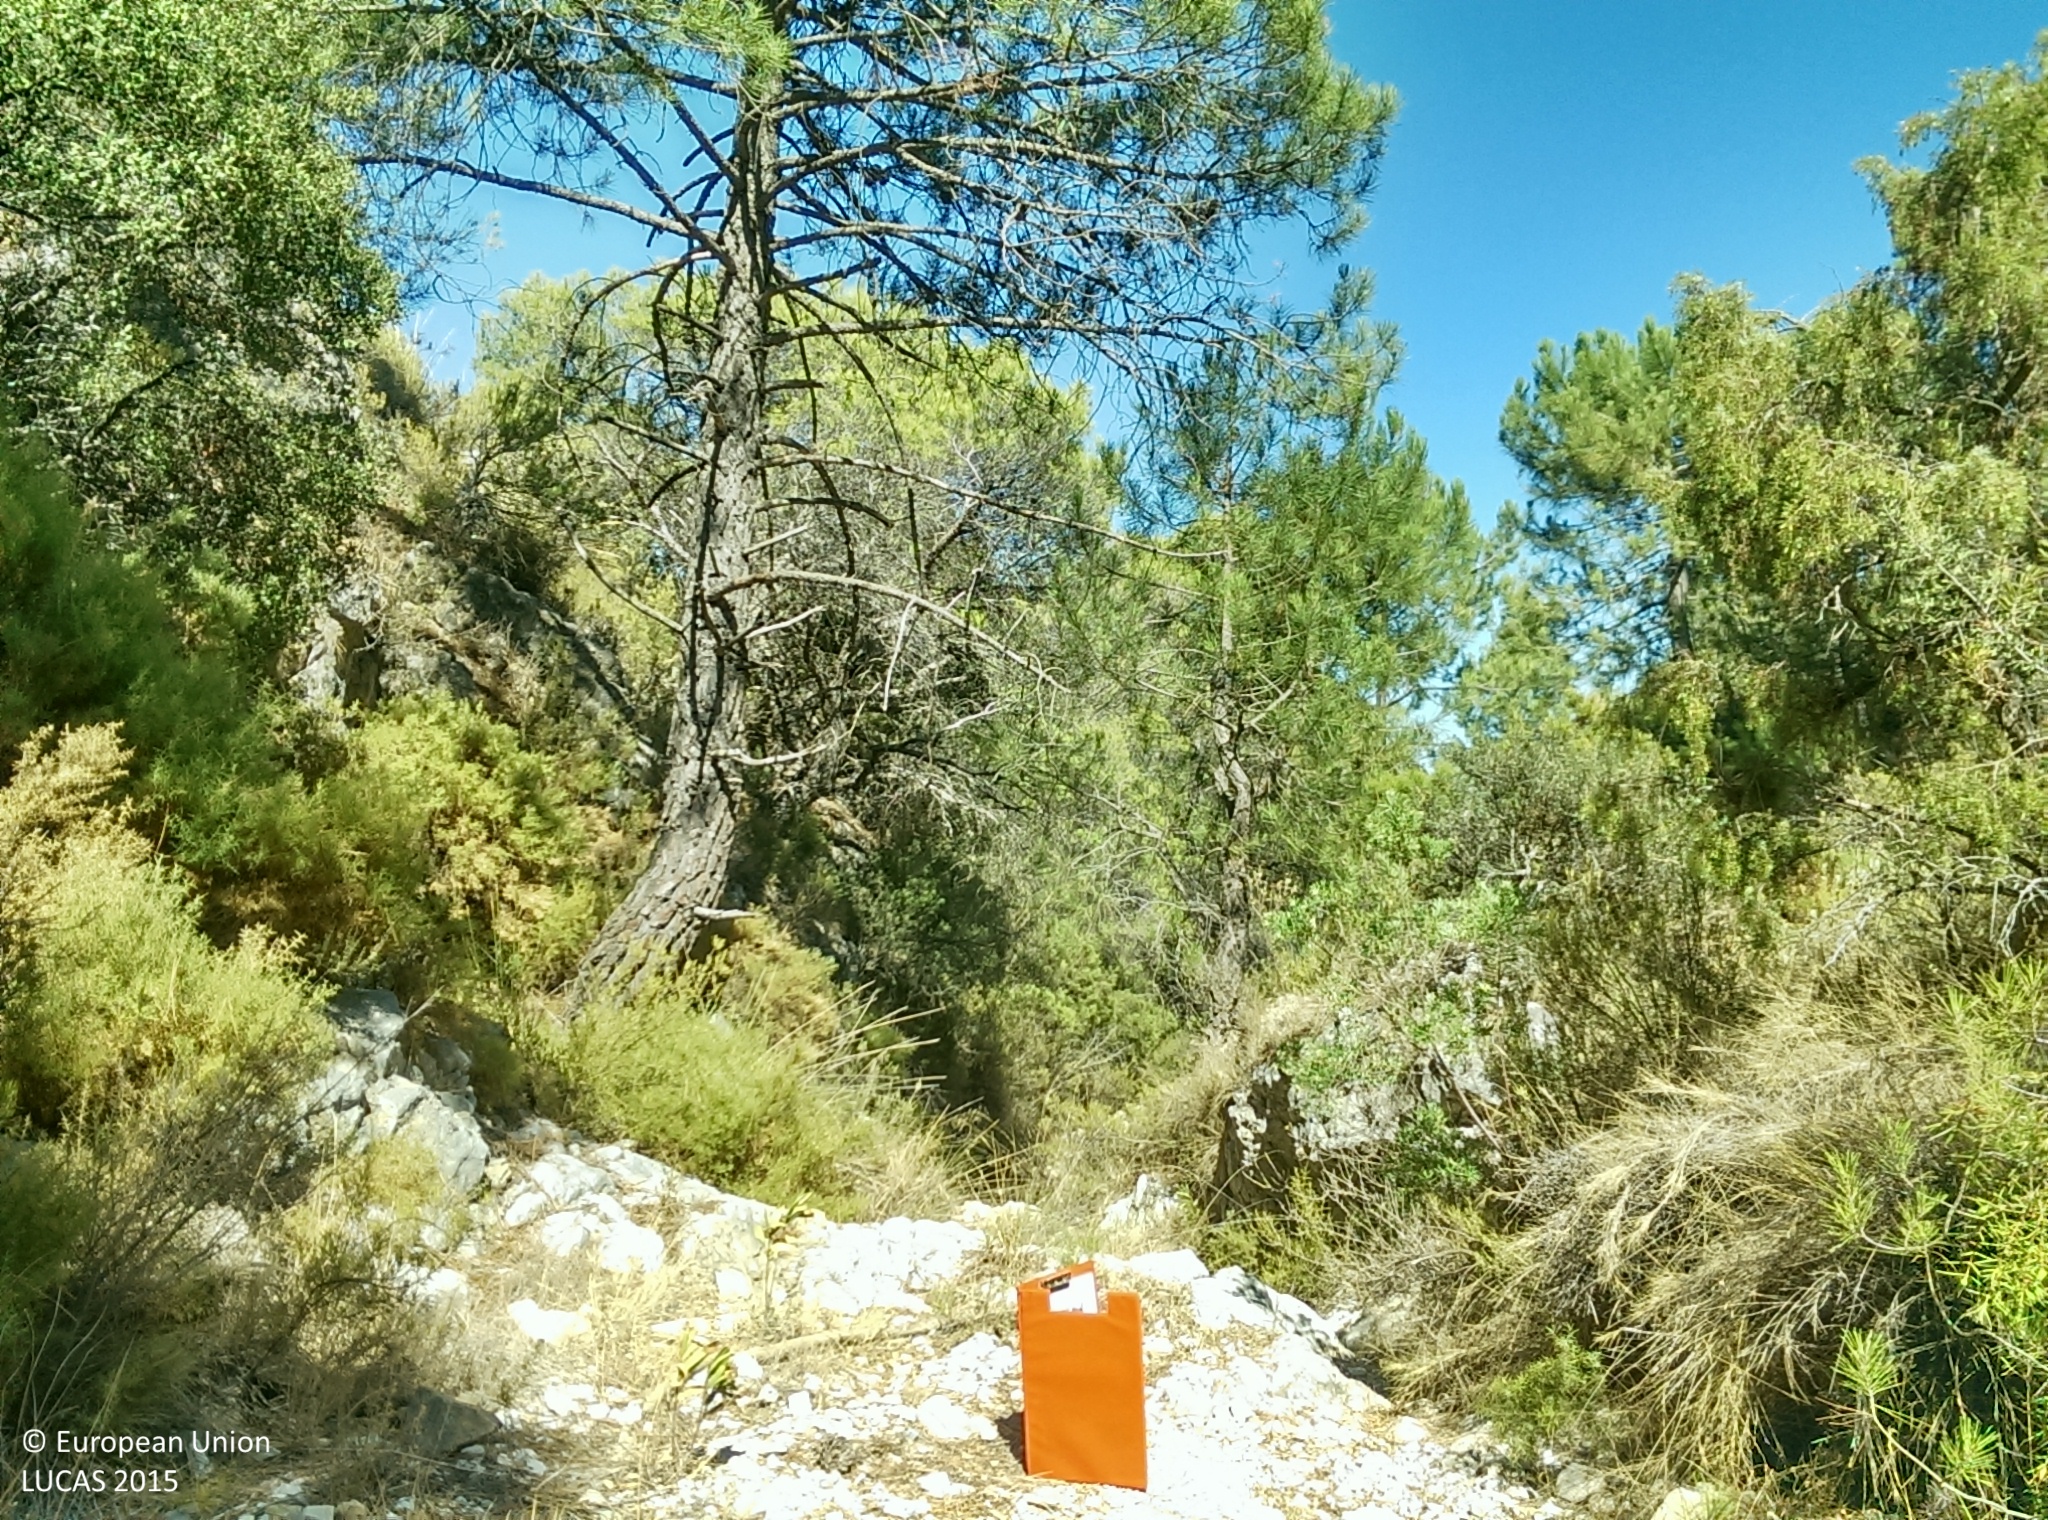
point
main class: Woodland
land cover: Pine dominated coniferous woodland
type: coniferous forest of the mediterranean region
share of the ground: 50 - 75 %
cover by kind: coniferous forest trees 65 %, shrubs 20 %, herbaceous plants 10 %, unconsolidated bare surface 5 %
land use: Forestry
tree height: > 5 m
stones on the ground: > 50 %
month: August
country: ES
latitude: 36.8946
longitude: -3.5963
